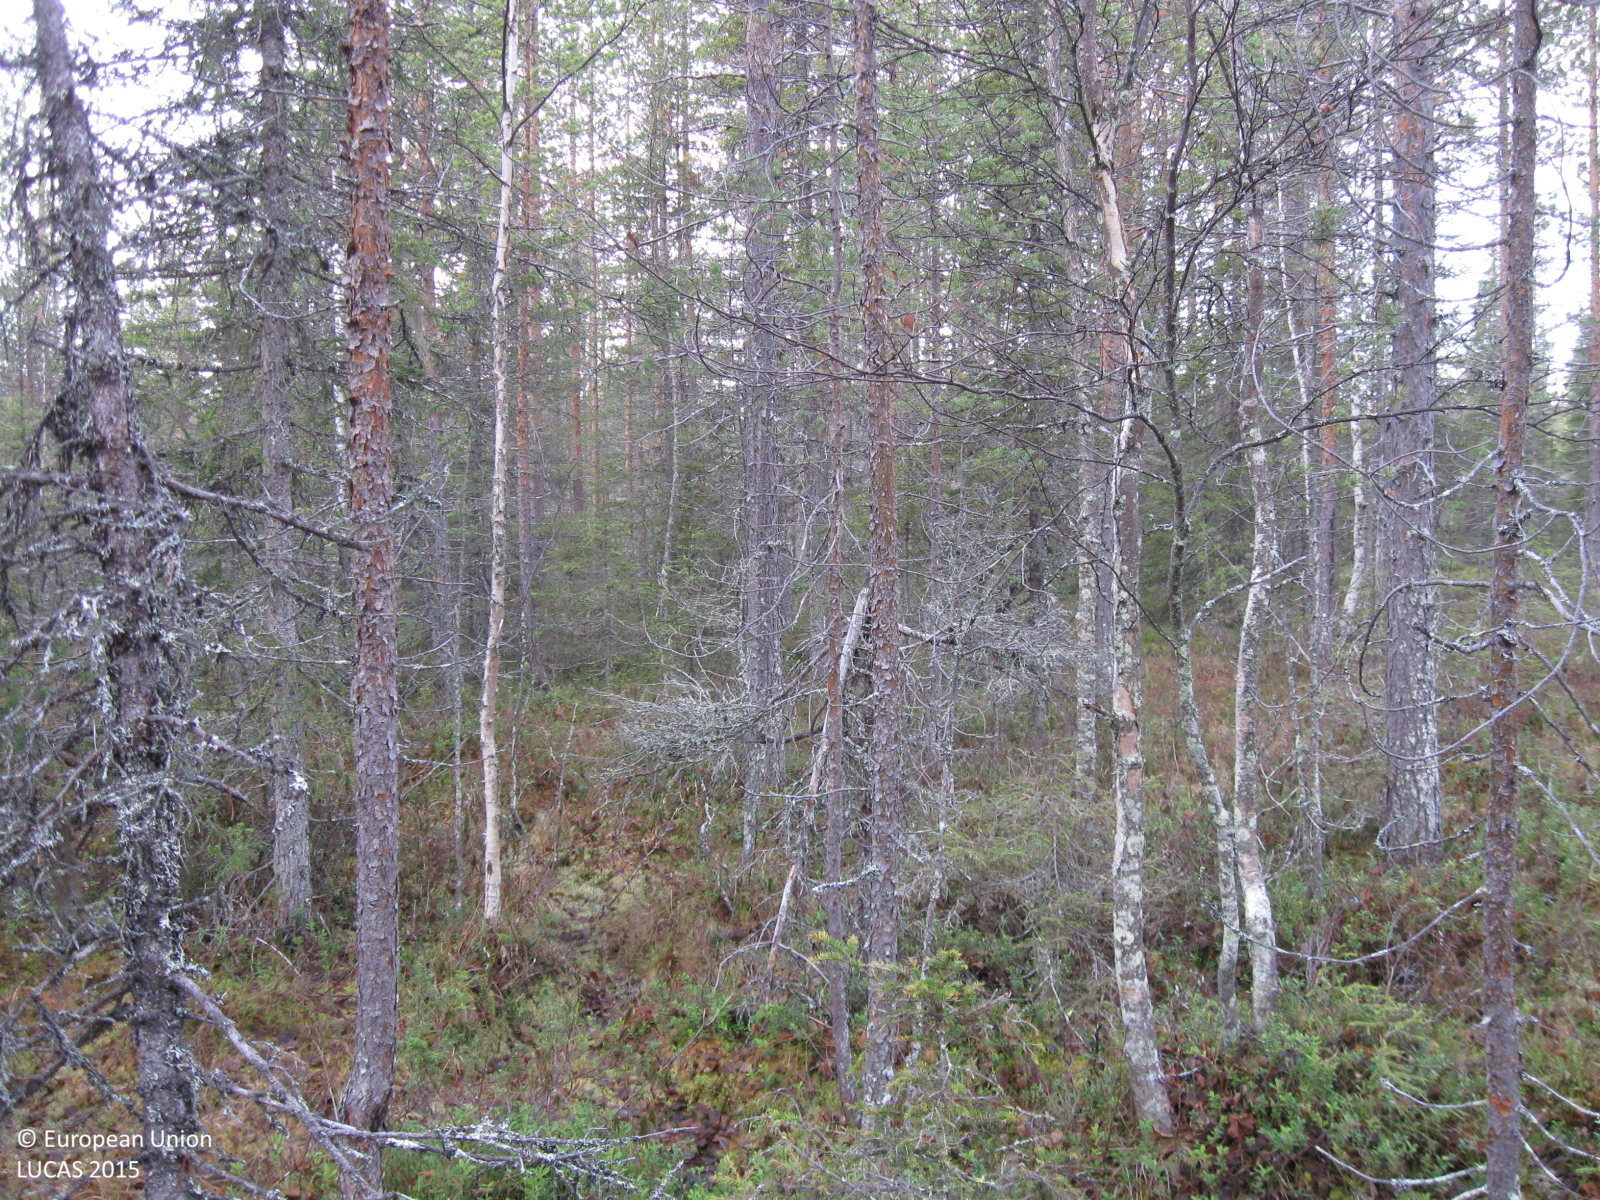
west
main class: Woodland
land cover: Pine dominated coniferous woodland
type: mire and swamp forests
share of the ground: 50 - 75 %
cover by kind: coniferous forest trees 60 %, shrubs 15 %, broadleaved forest trees 10 %, lichens and mosses 10 %, herbaceous plants 5 %
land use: Forestry
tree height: > 5 m
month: November
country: SE
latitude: 66.0175
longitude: 20.5672
